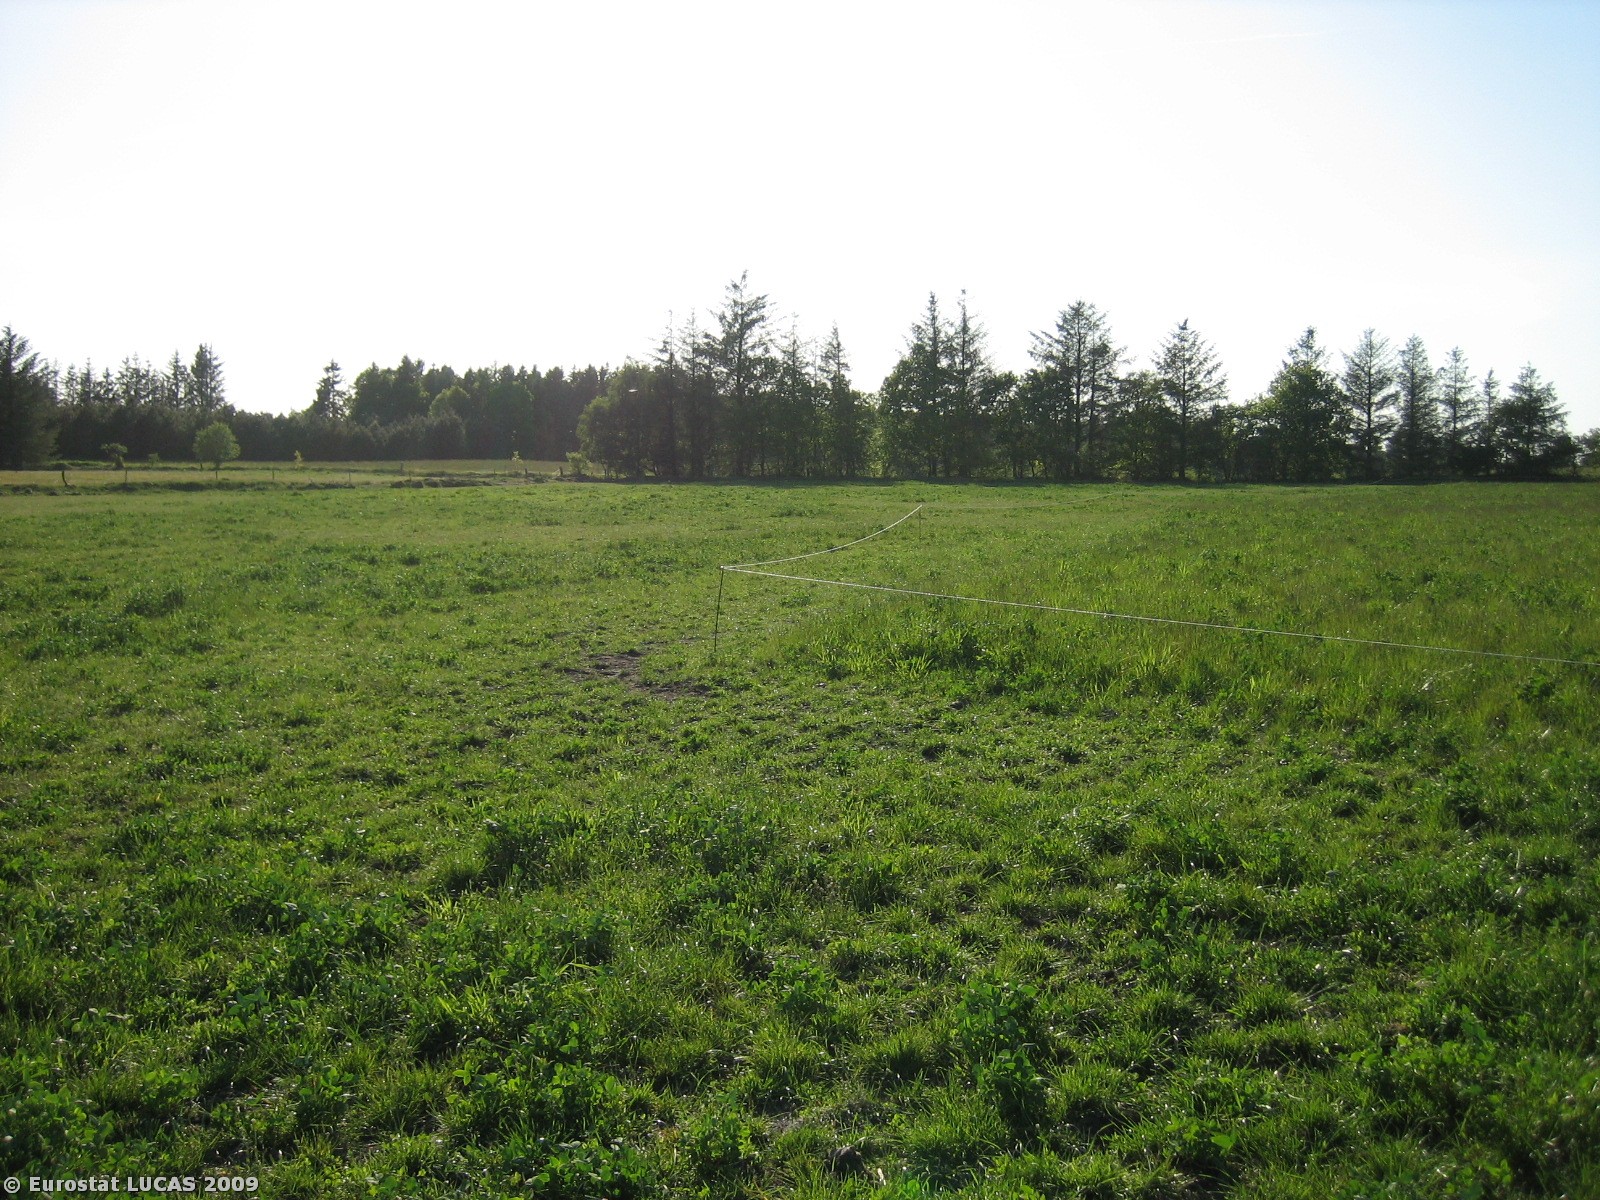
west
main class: Grassland
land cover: Grassland without tree/shrub cover
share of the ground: > 75 %
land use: Agriculture (excluding fallow land and kitchen gardens)
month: May
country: DK
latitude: 55.8422
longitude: 8.9950
